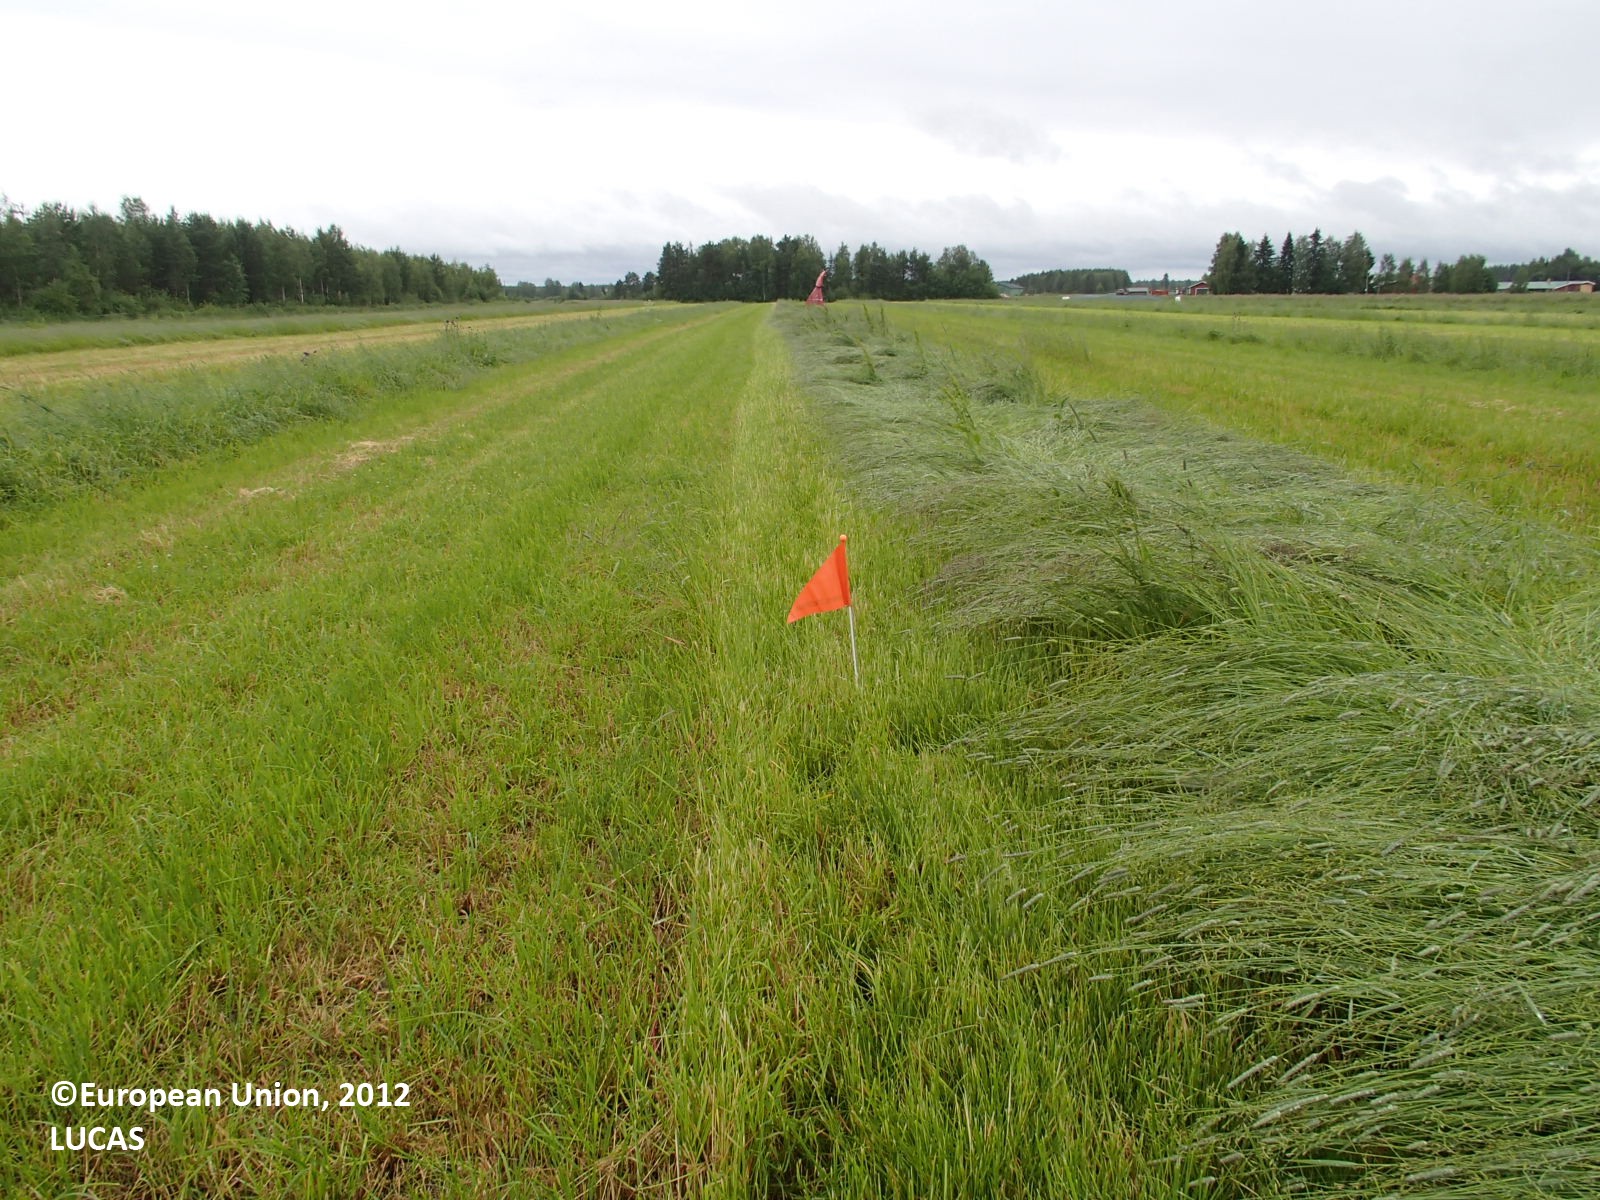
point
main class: Cropland
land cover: Temporary grasslands
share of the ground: > 75 %
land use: Agriculture (excluding fallow land and kitchen gardens)
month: July
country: FI
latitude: 64.4072
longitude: 26.4004
